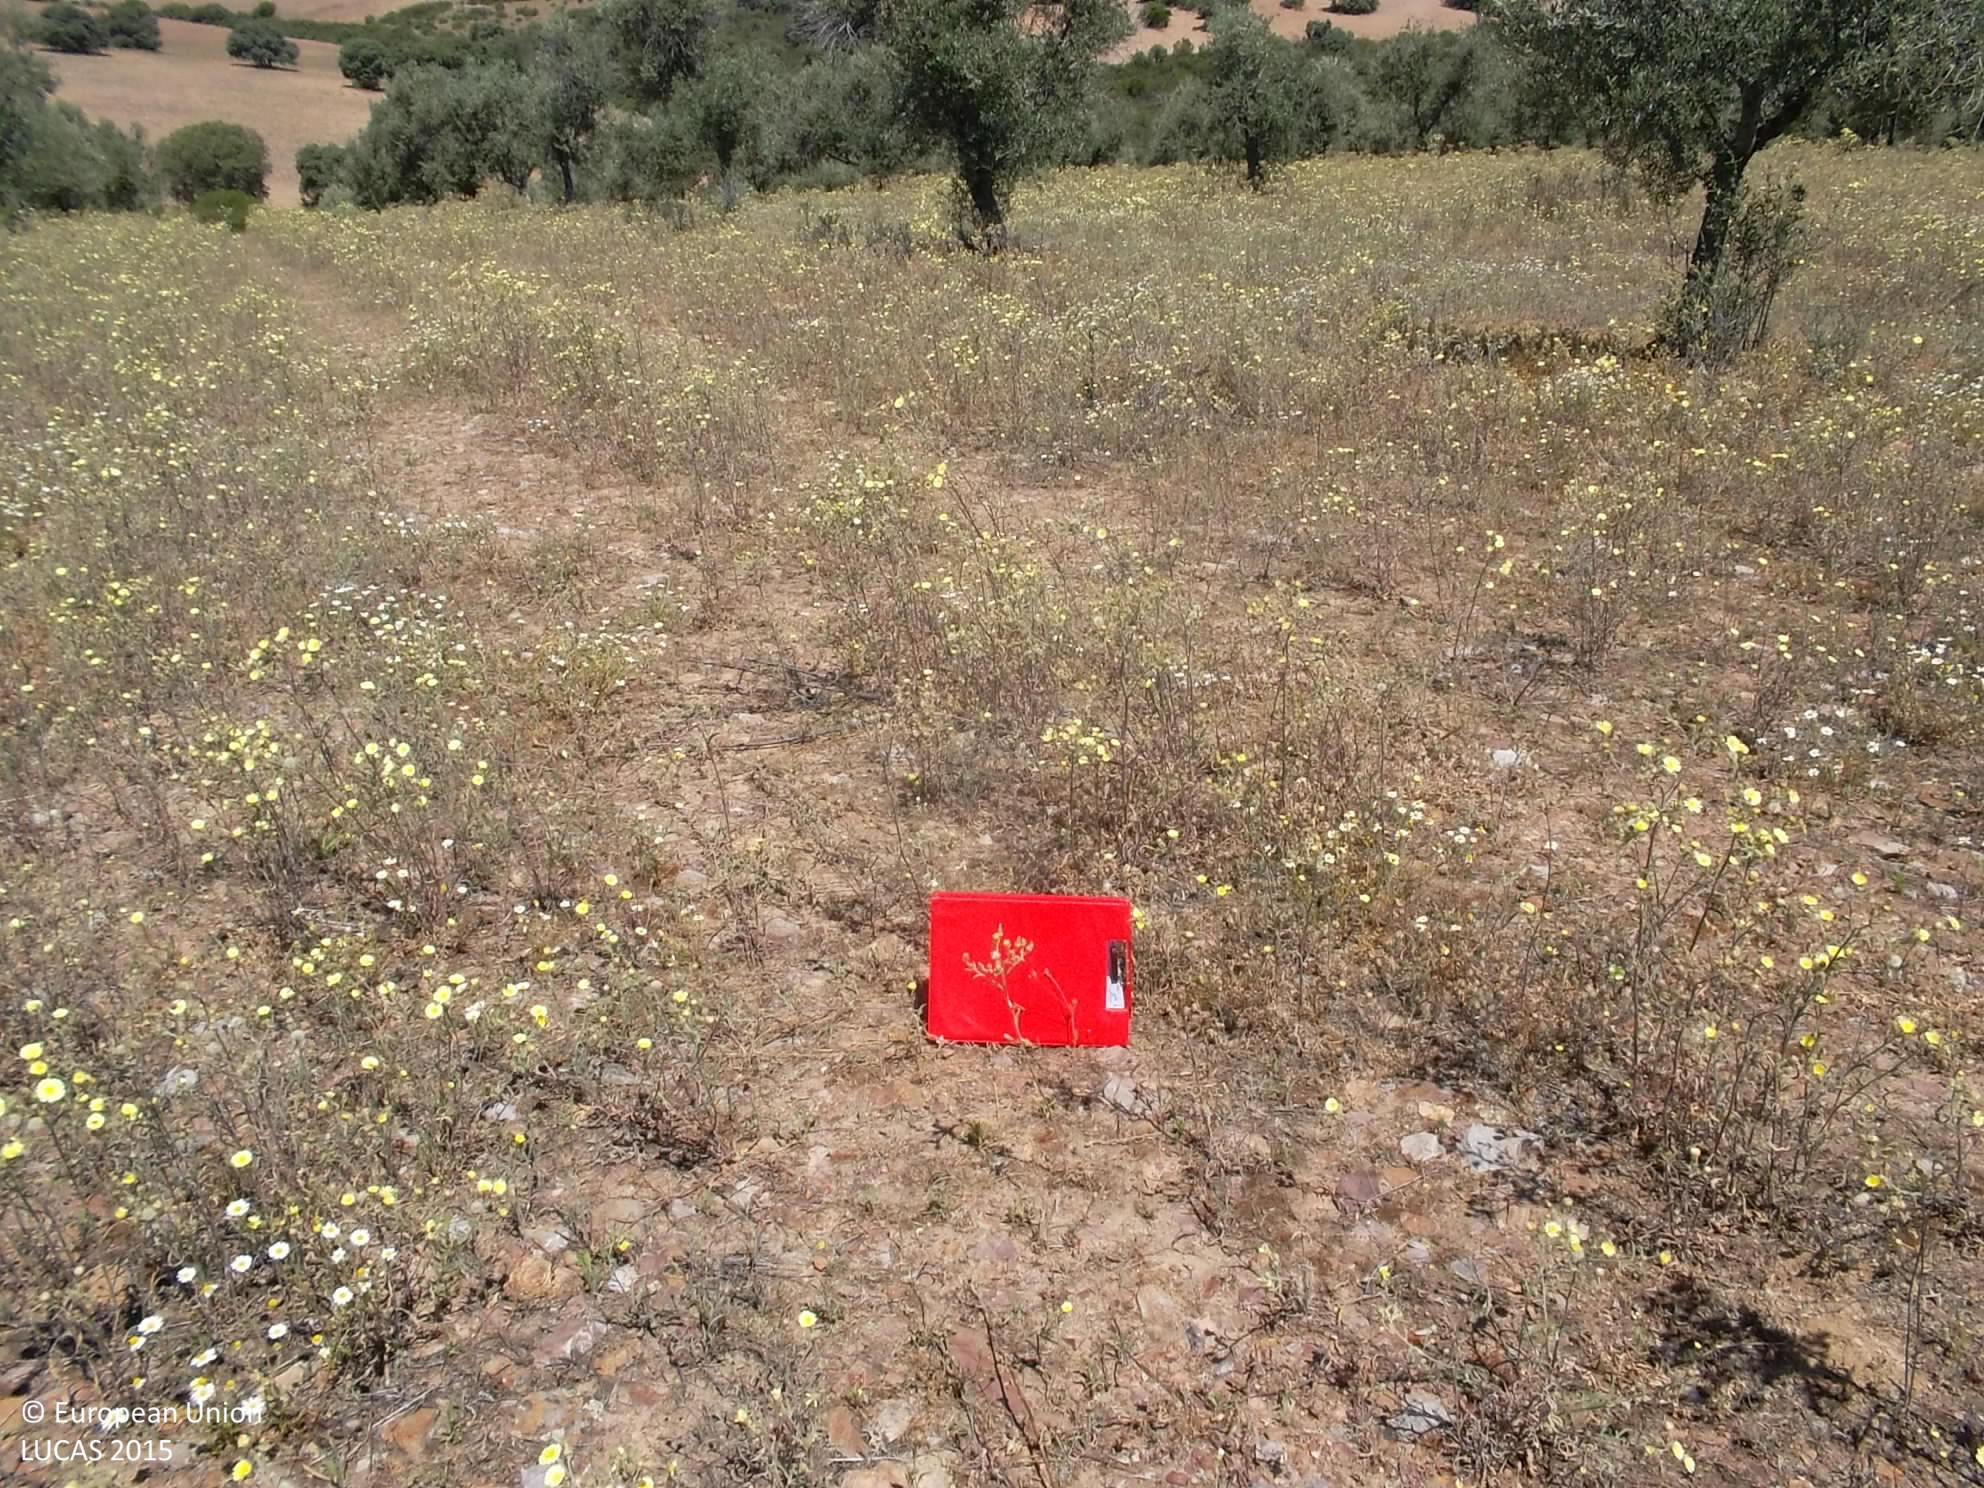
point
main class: Cropland
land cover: Olive groves
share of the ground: 25 - 50 %
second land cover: Spontaneously vegetated surfaces
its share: 50 - 75 %
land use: Agriculture (excluding fallow land and kitchen gardens)
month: May
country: ES
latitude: 38.7910
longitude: -4.4267
